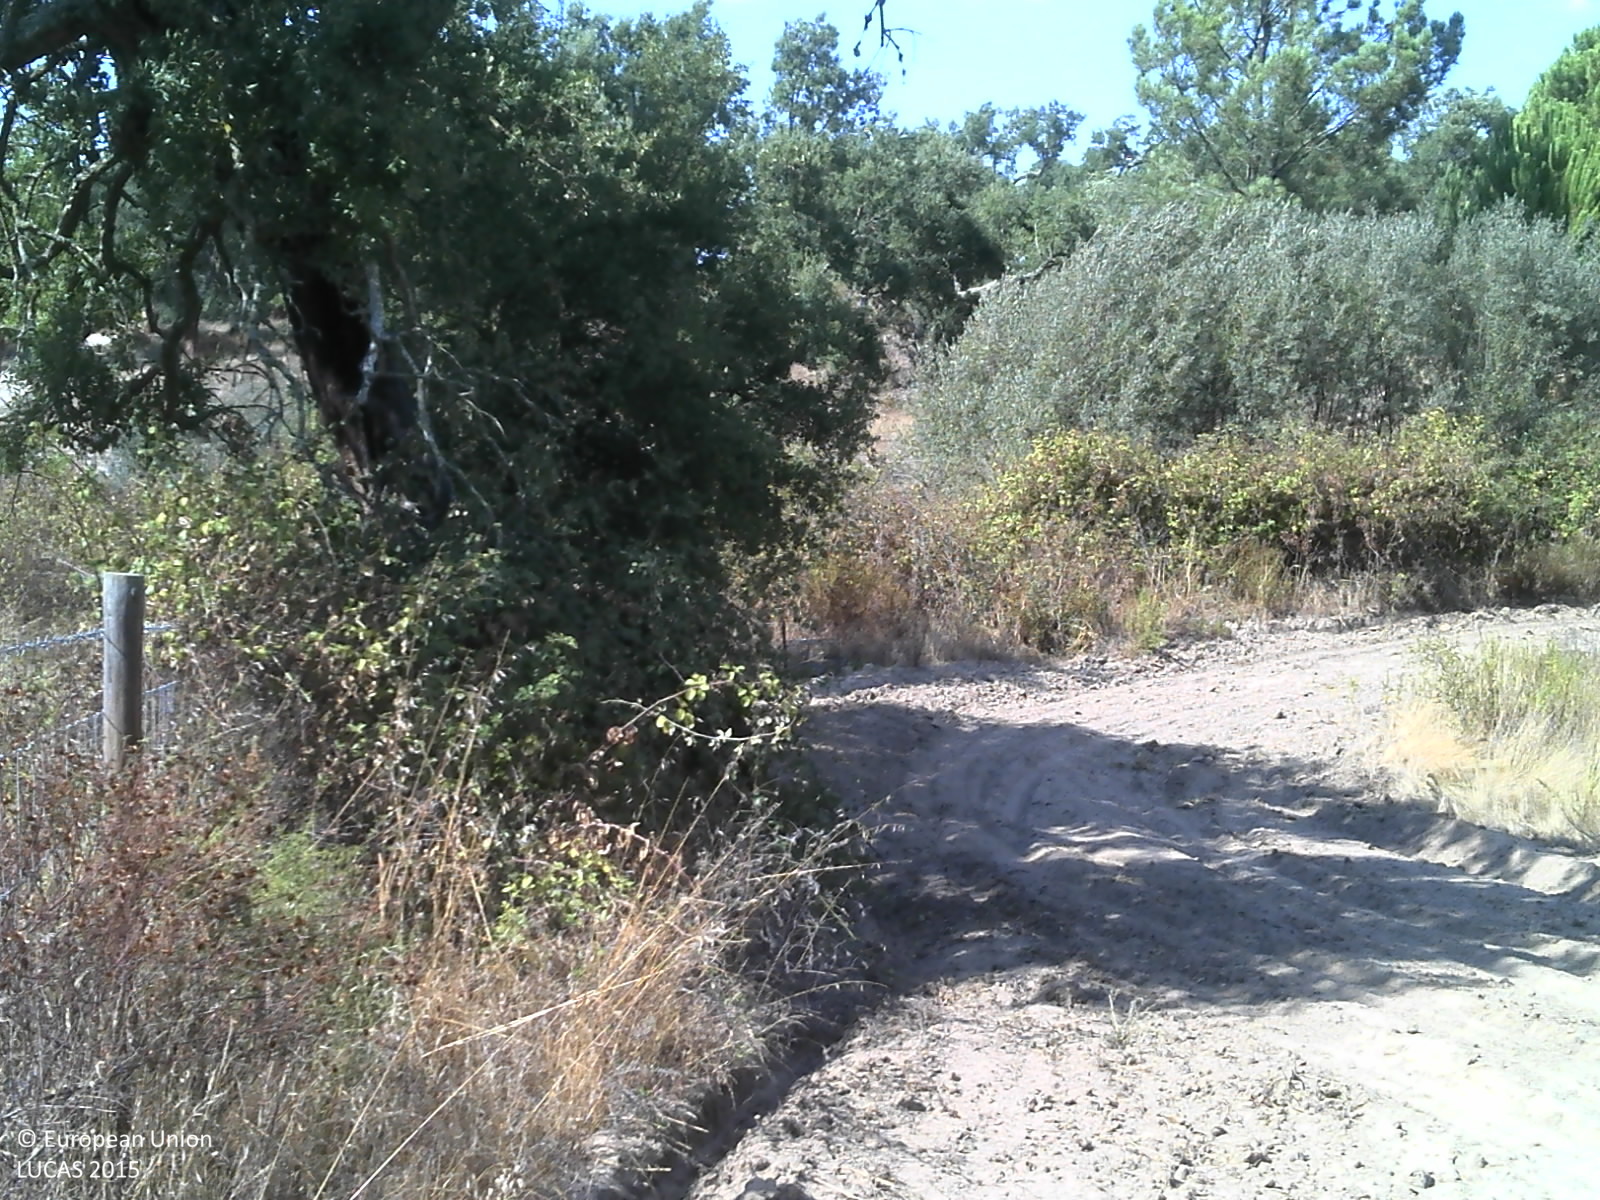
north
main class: Woodland
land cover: Pine dominated coniferous woodland
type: coniferous forest of the mediterranean region
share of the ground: 25 - 50 %
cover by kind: coniferous forest trees 50 %, herbaceous plants 35 %, unconsolidated bare surface 15 %
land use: Forestry
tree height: < 5 m
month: August
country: PT
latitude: 38.7448
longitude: -8.5248
